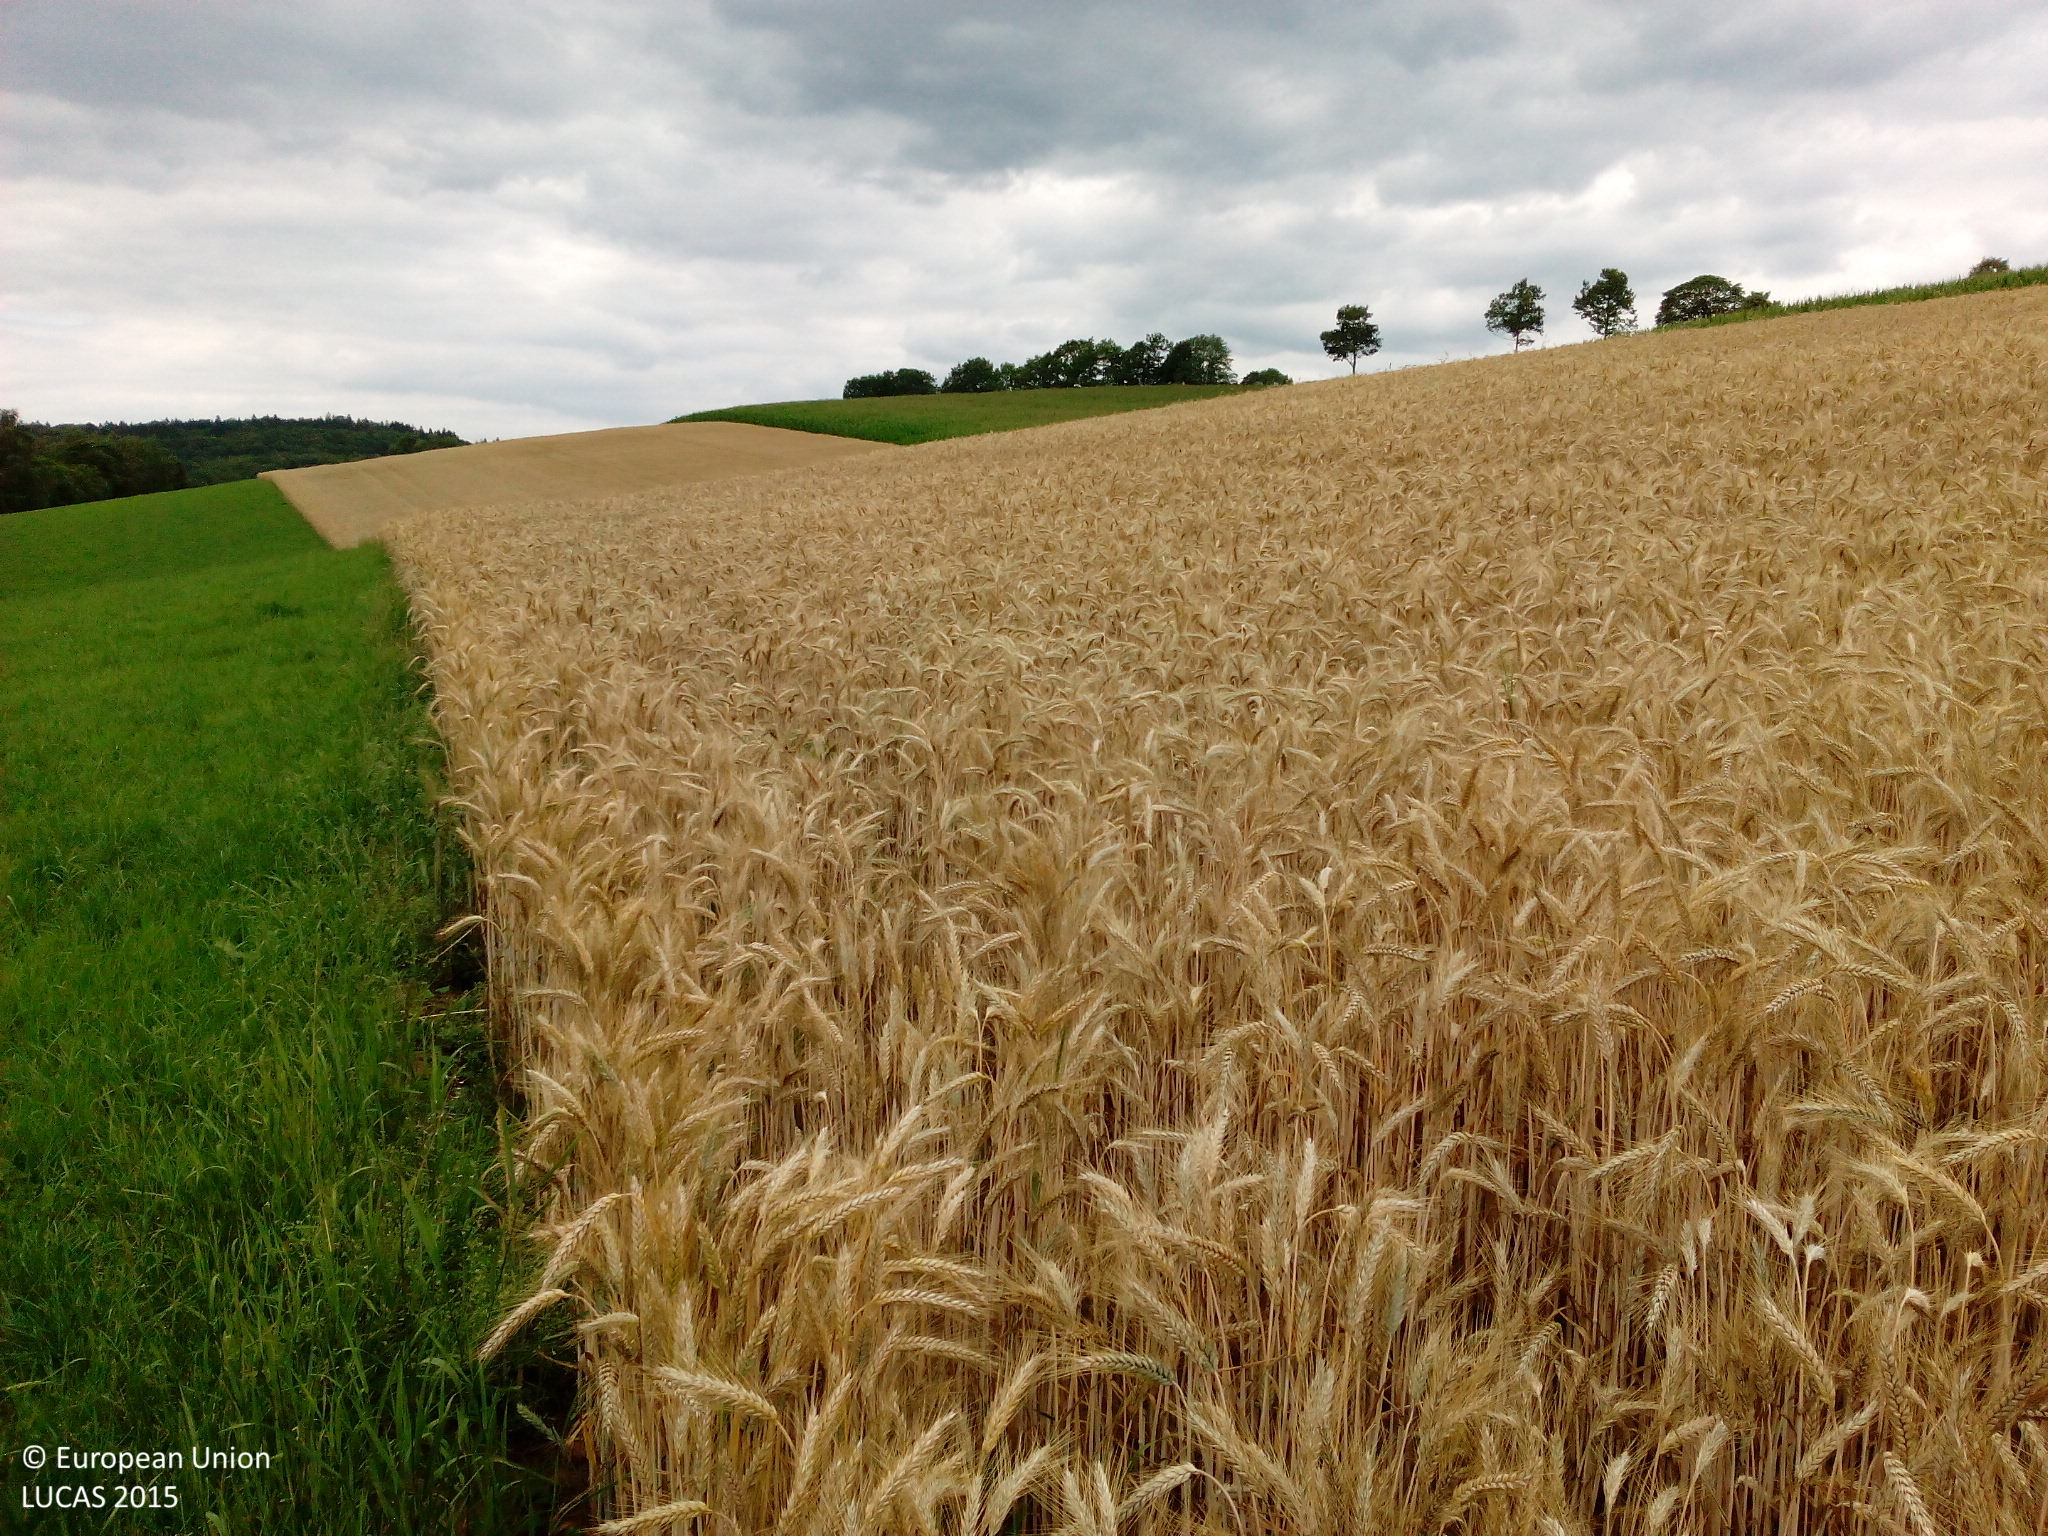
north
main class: Cropland
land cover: Barley
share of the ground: > 75 %
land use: Agriculture (excluding fallow land and kitchen gardens)
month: July
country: DE
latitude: 50.5078
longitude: 9.8731
